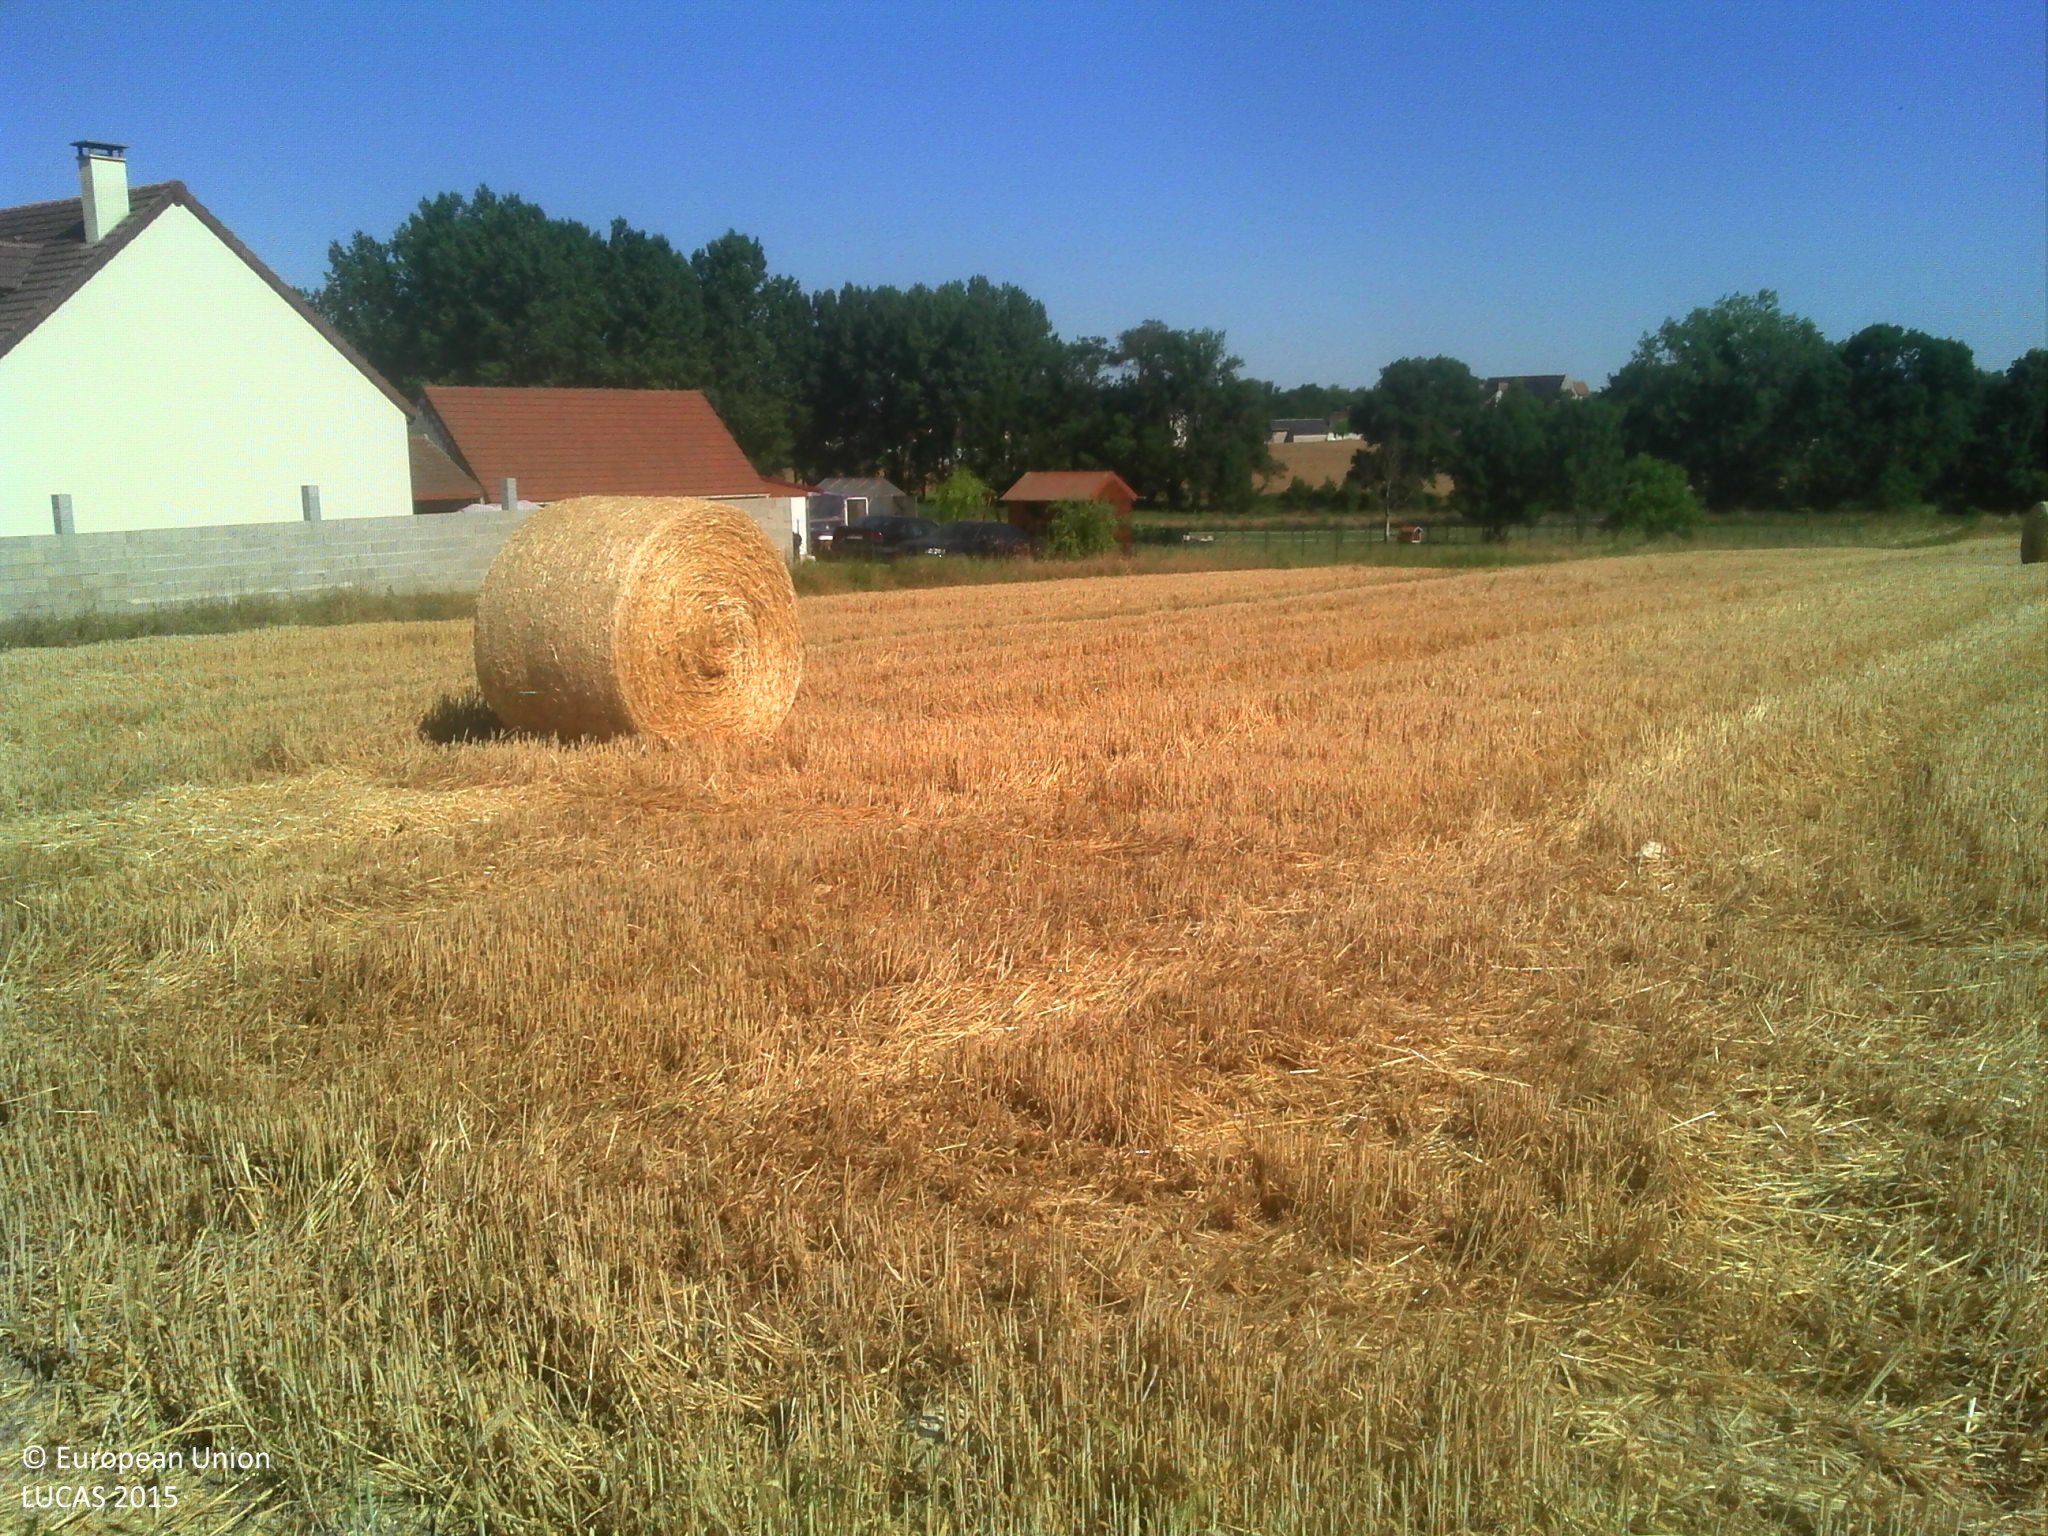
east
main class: Cropland
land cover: Barley
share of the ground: > 75 %
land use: Agriculture (excluding fallow land and kitchen gardens)
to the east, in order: Barley; Grass margins; Artificial constructions in urban areas; Fences; Grassland with sparse tree/shrub cover; Artificial constructions in urban areas; Conifer hedges; Fences; Grassland without tree/shrub cover; Fences; Grassland without tree/shrub cover; Fences; Grassland without tree/shrub cover; Other fresh vegetables; Artificial constructions in urban areas
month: June
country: FR
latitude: 47.3300
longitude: 1.4513
